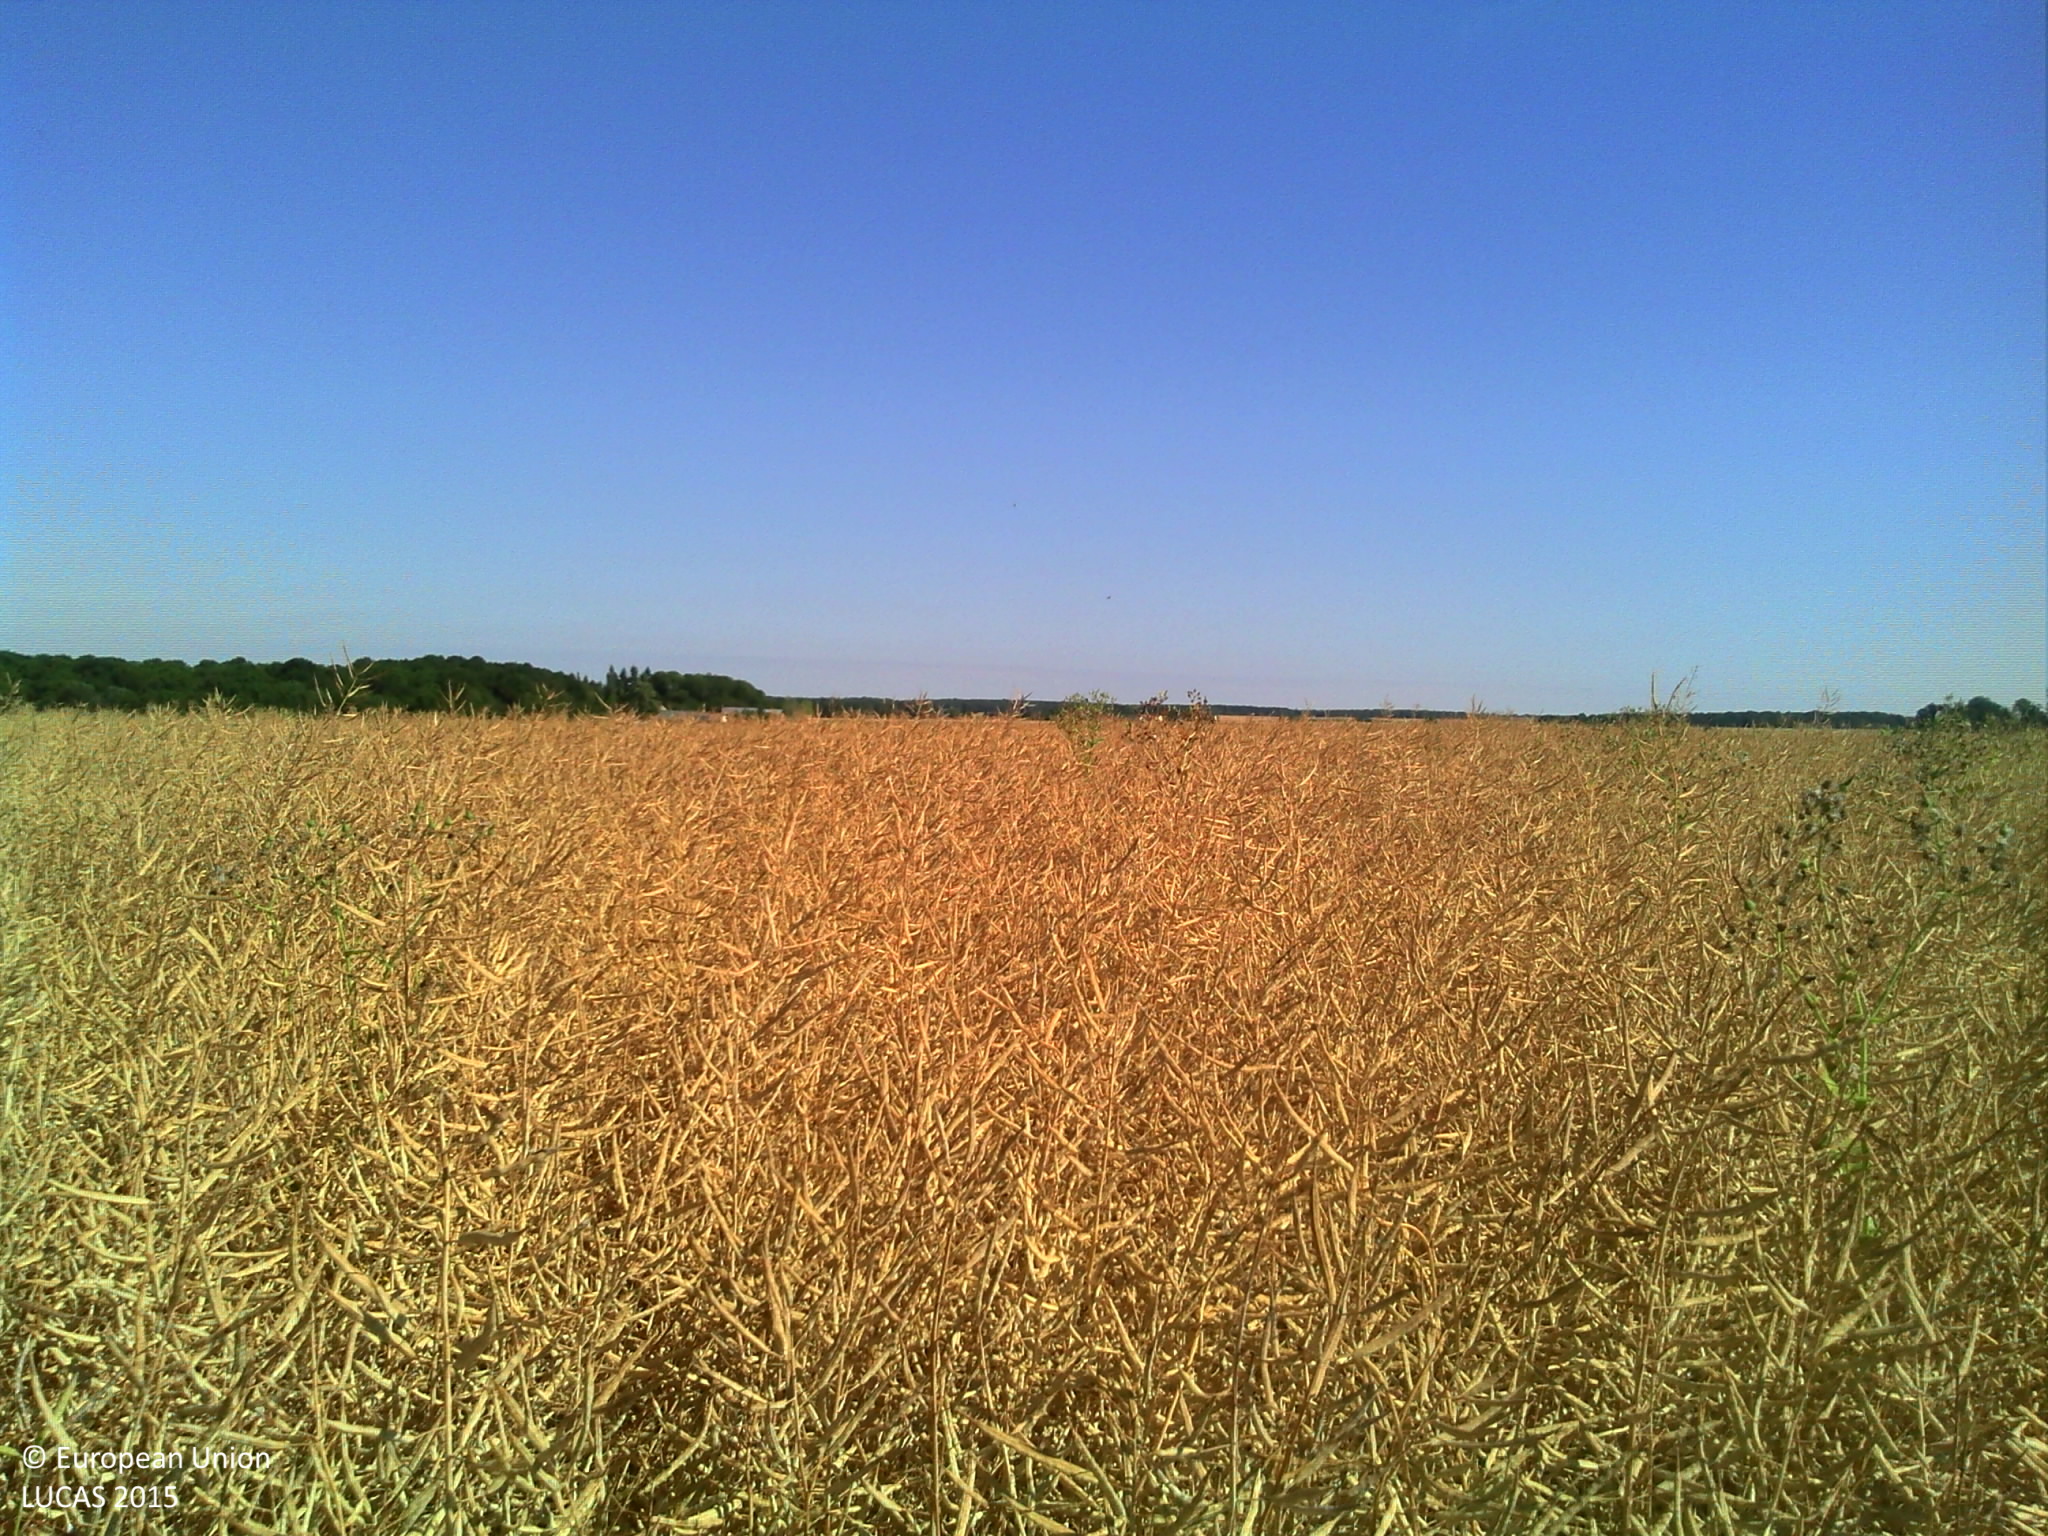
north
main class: Cropland
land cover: Rape and turnip rape
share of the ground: > 75 %
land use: Agriculture (excluding fallow land and kitchen gardens)
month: July
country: FR
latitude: 47.9512
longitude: 3.0707
